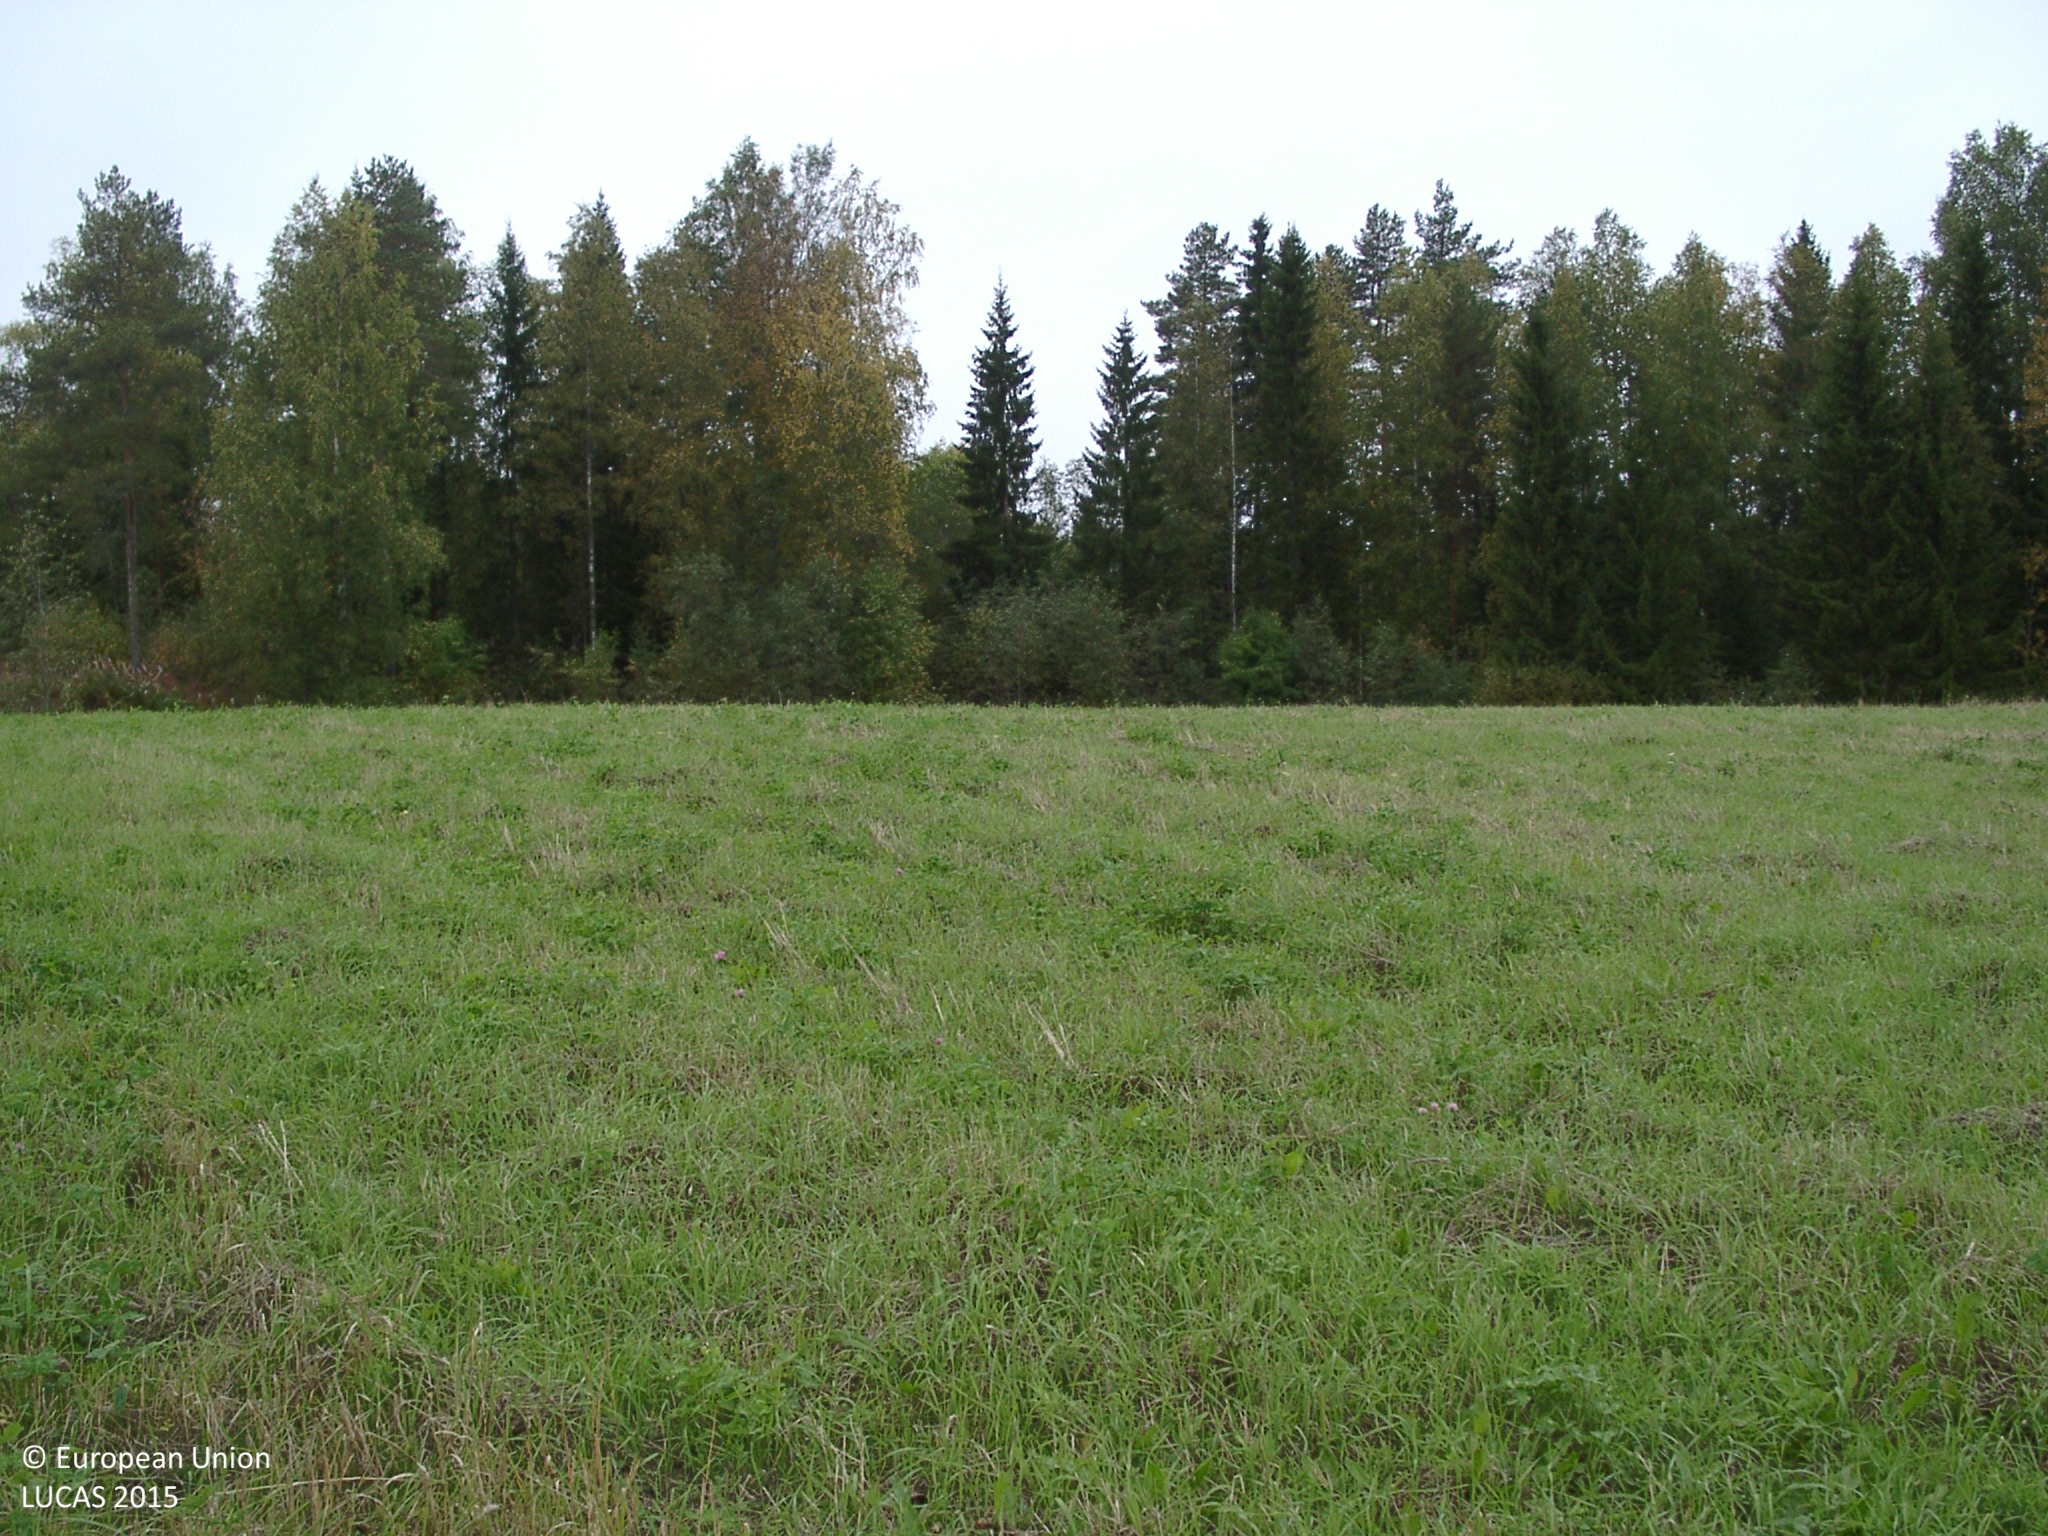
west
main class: Cropland
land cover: Other leguminous and mixtures for fodder
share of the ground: > 75 %
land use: Agriculture (excluding fallow land and kitchen gardens)
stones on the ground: < 10 %
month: September
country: FI
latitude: 62.5781
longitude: 25.6663
